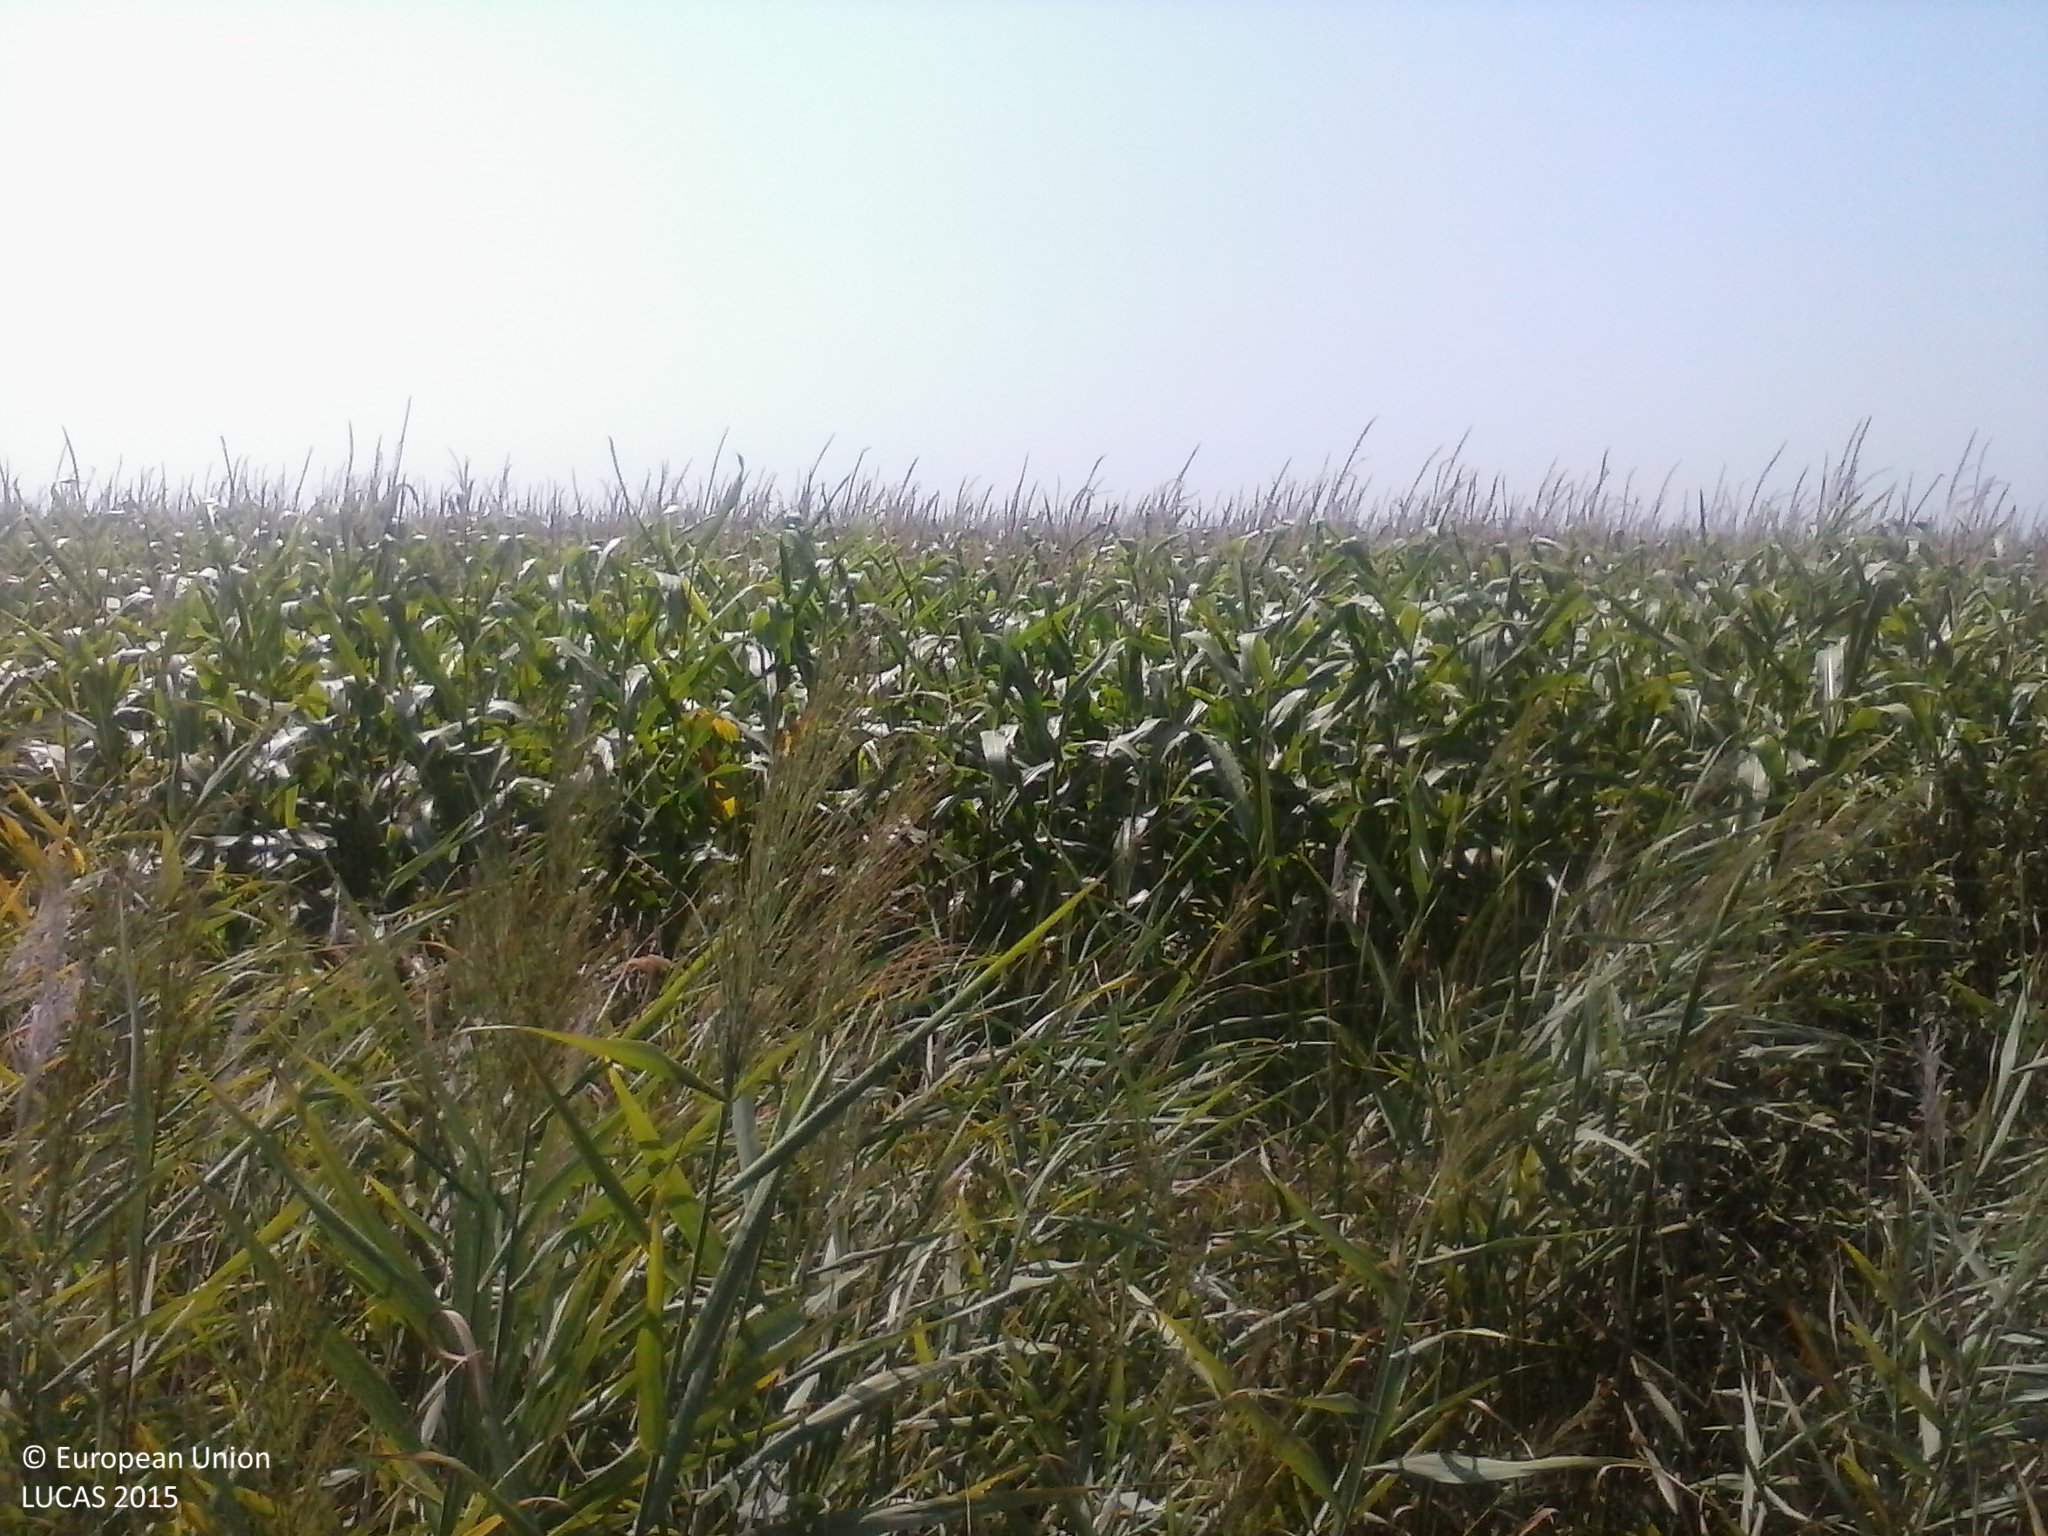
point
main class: Cropland
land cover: Maize
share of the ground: > 75 %
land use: Agriculture (excluding fallow land and kitchen gardens)
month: August
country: HU
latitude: 45.9313
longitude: 17.9105
